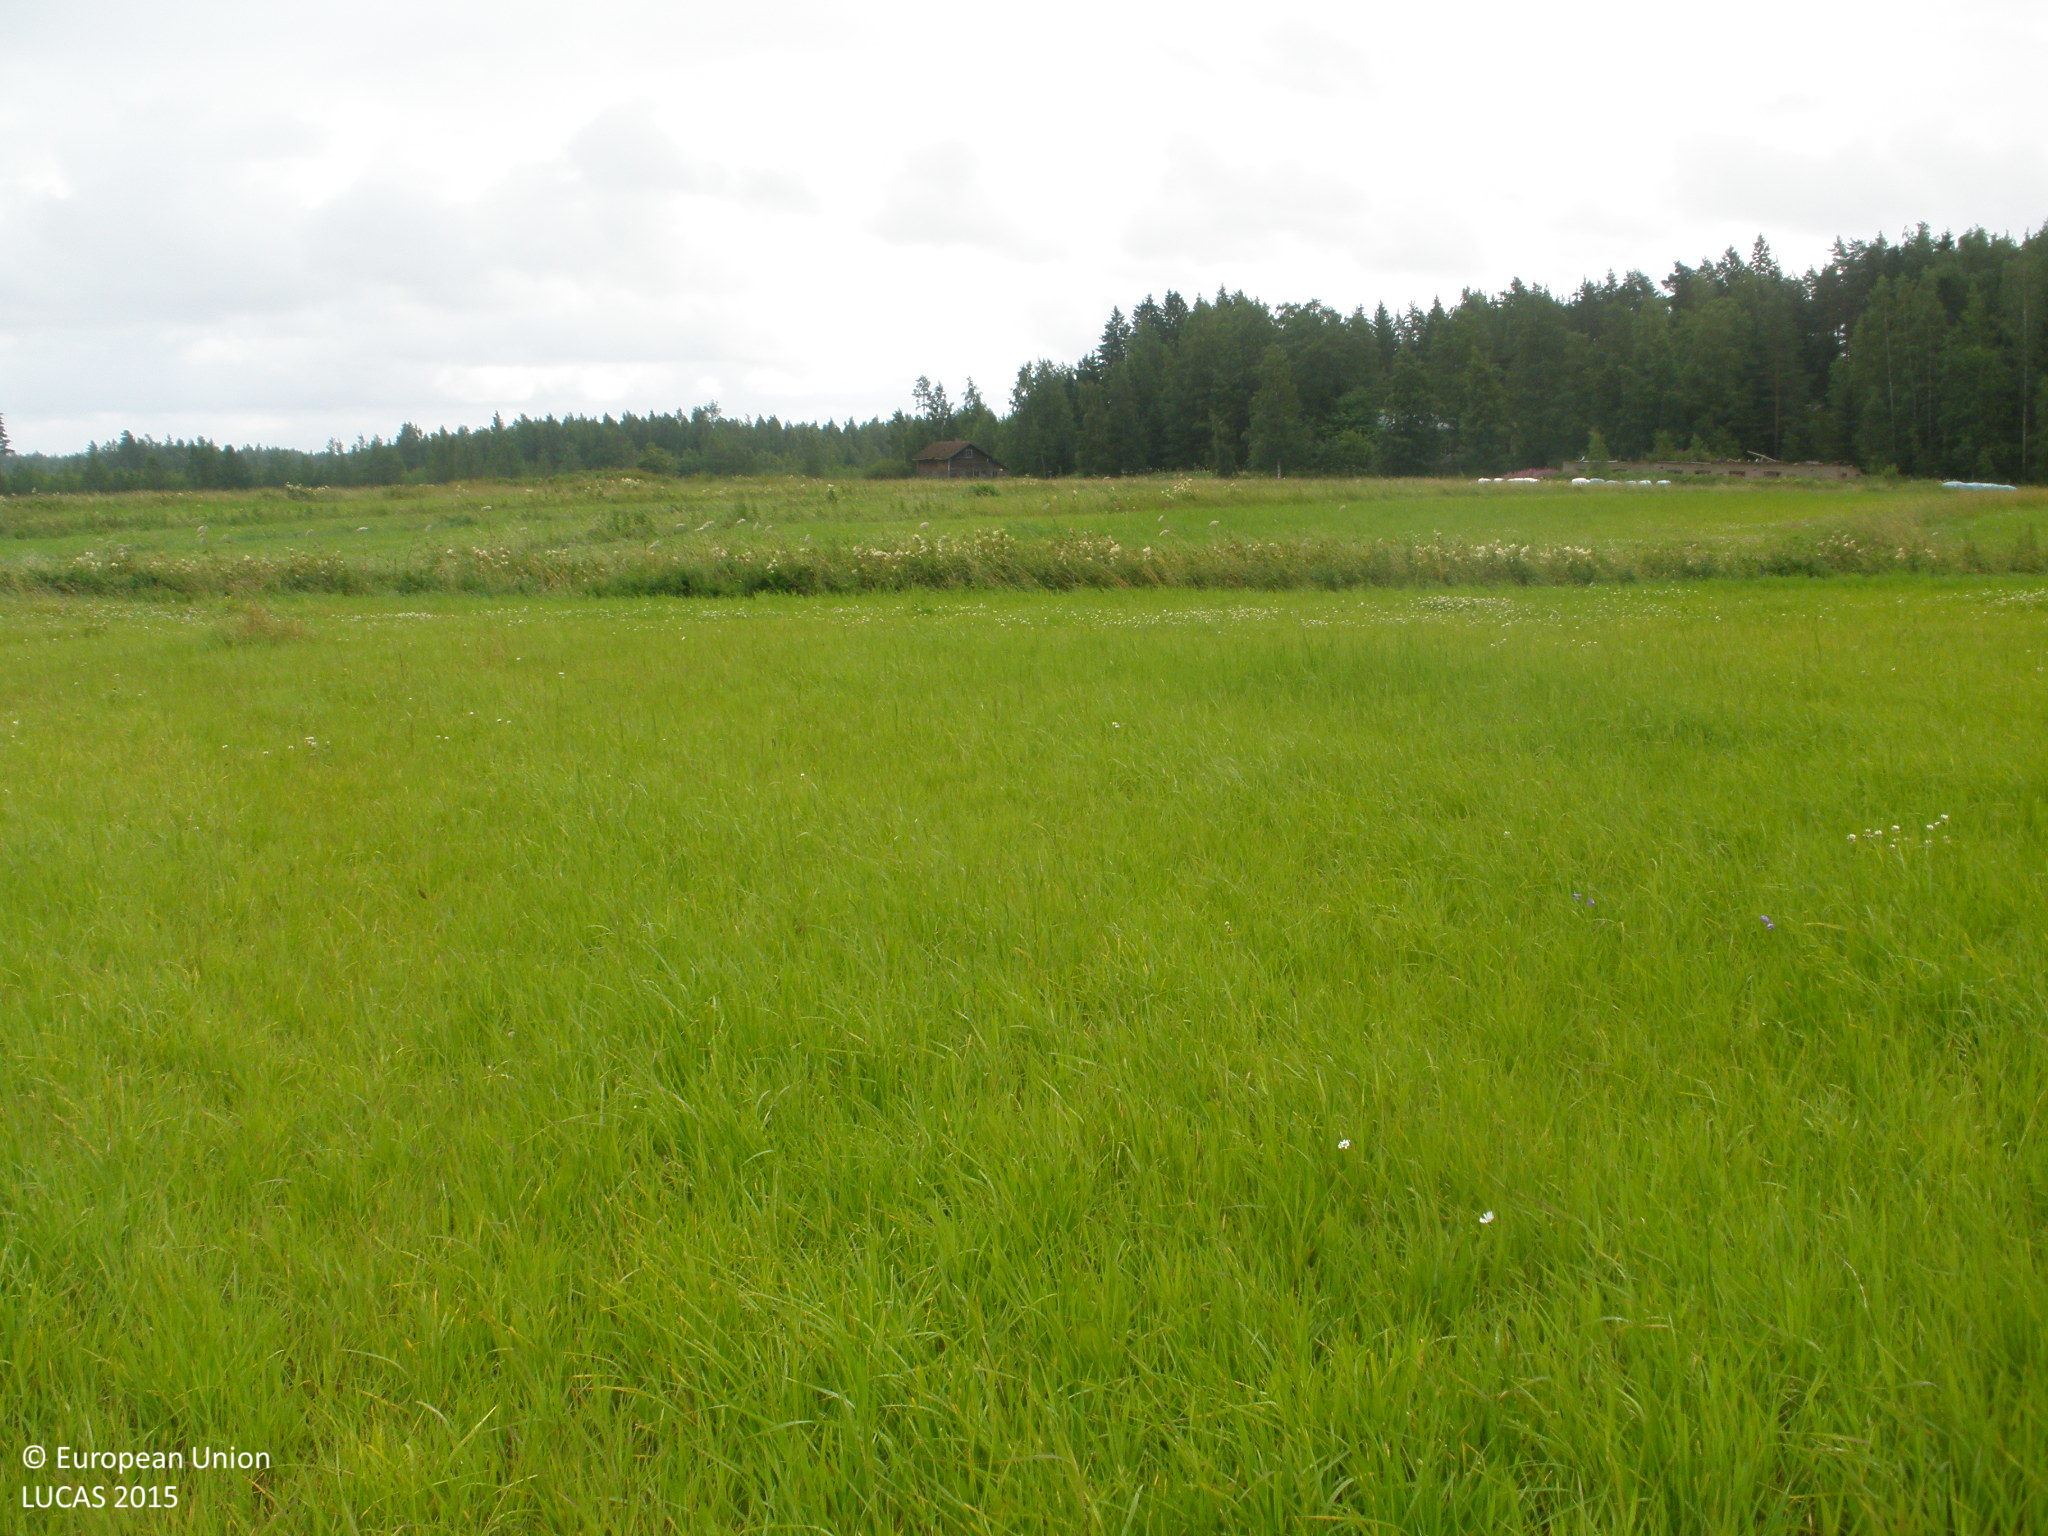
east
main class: Cropland
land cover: Temporary grasslands
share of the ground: > 75 %
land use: Agriculture (excluding fallow land and kitchen gardens)
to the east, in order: Temporary grasslands; Ditches and canals; Temporary grasslands; Shruby margins; Temporary grasslands; Shruby margins; Temporary grasslands; Ditches and canals; Oats; Shrubland without tree cover; Oats; Ditches and canals; Oats; Ditches and canals; Oats; Ditches and canals; Oats; Ditches and canals; Oats; Ditches and canals; Oats; Ditches and canals; Oats
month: July
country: FI
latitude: 60.5464
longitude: 23.3750
